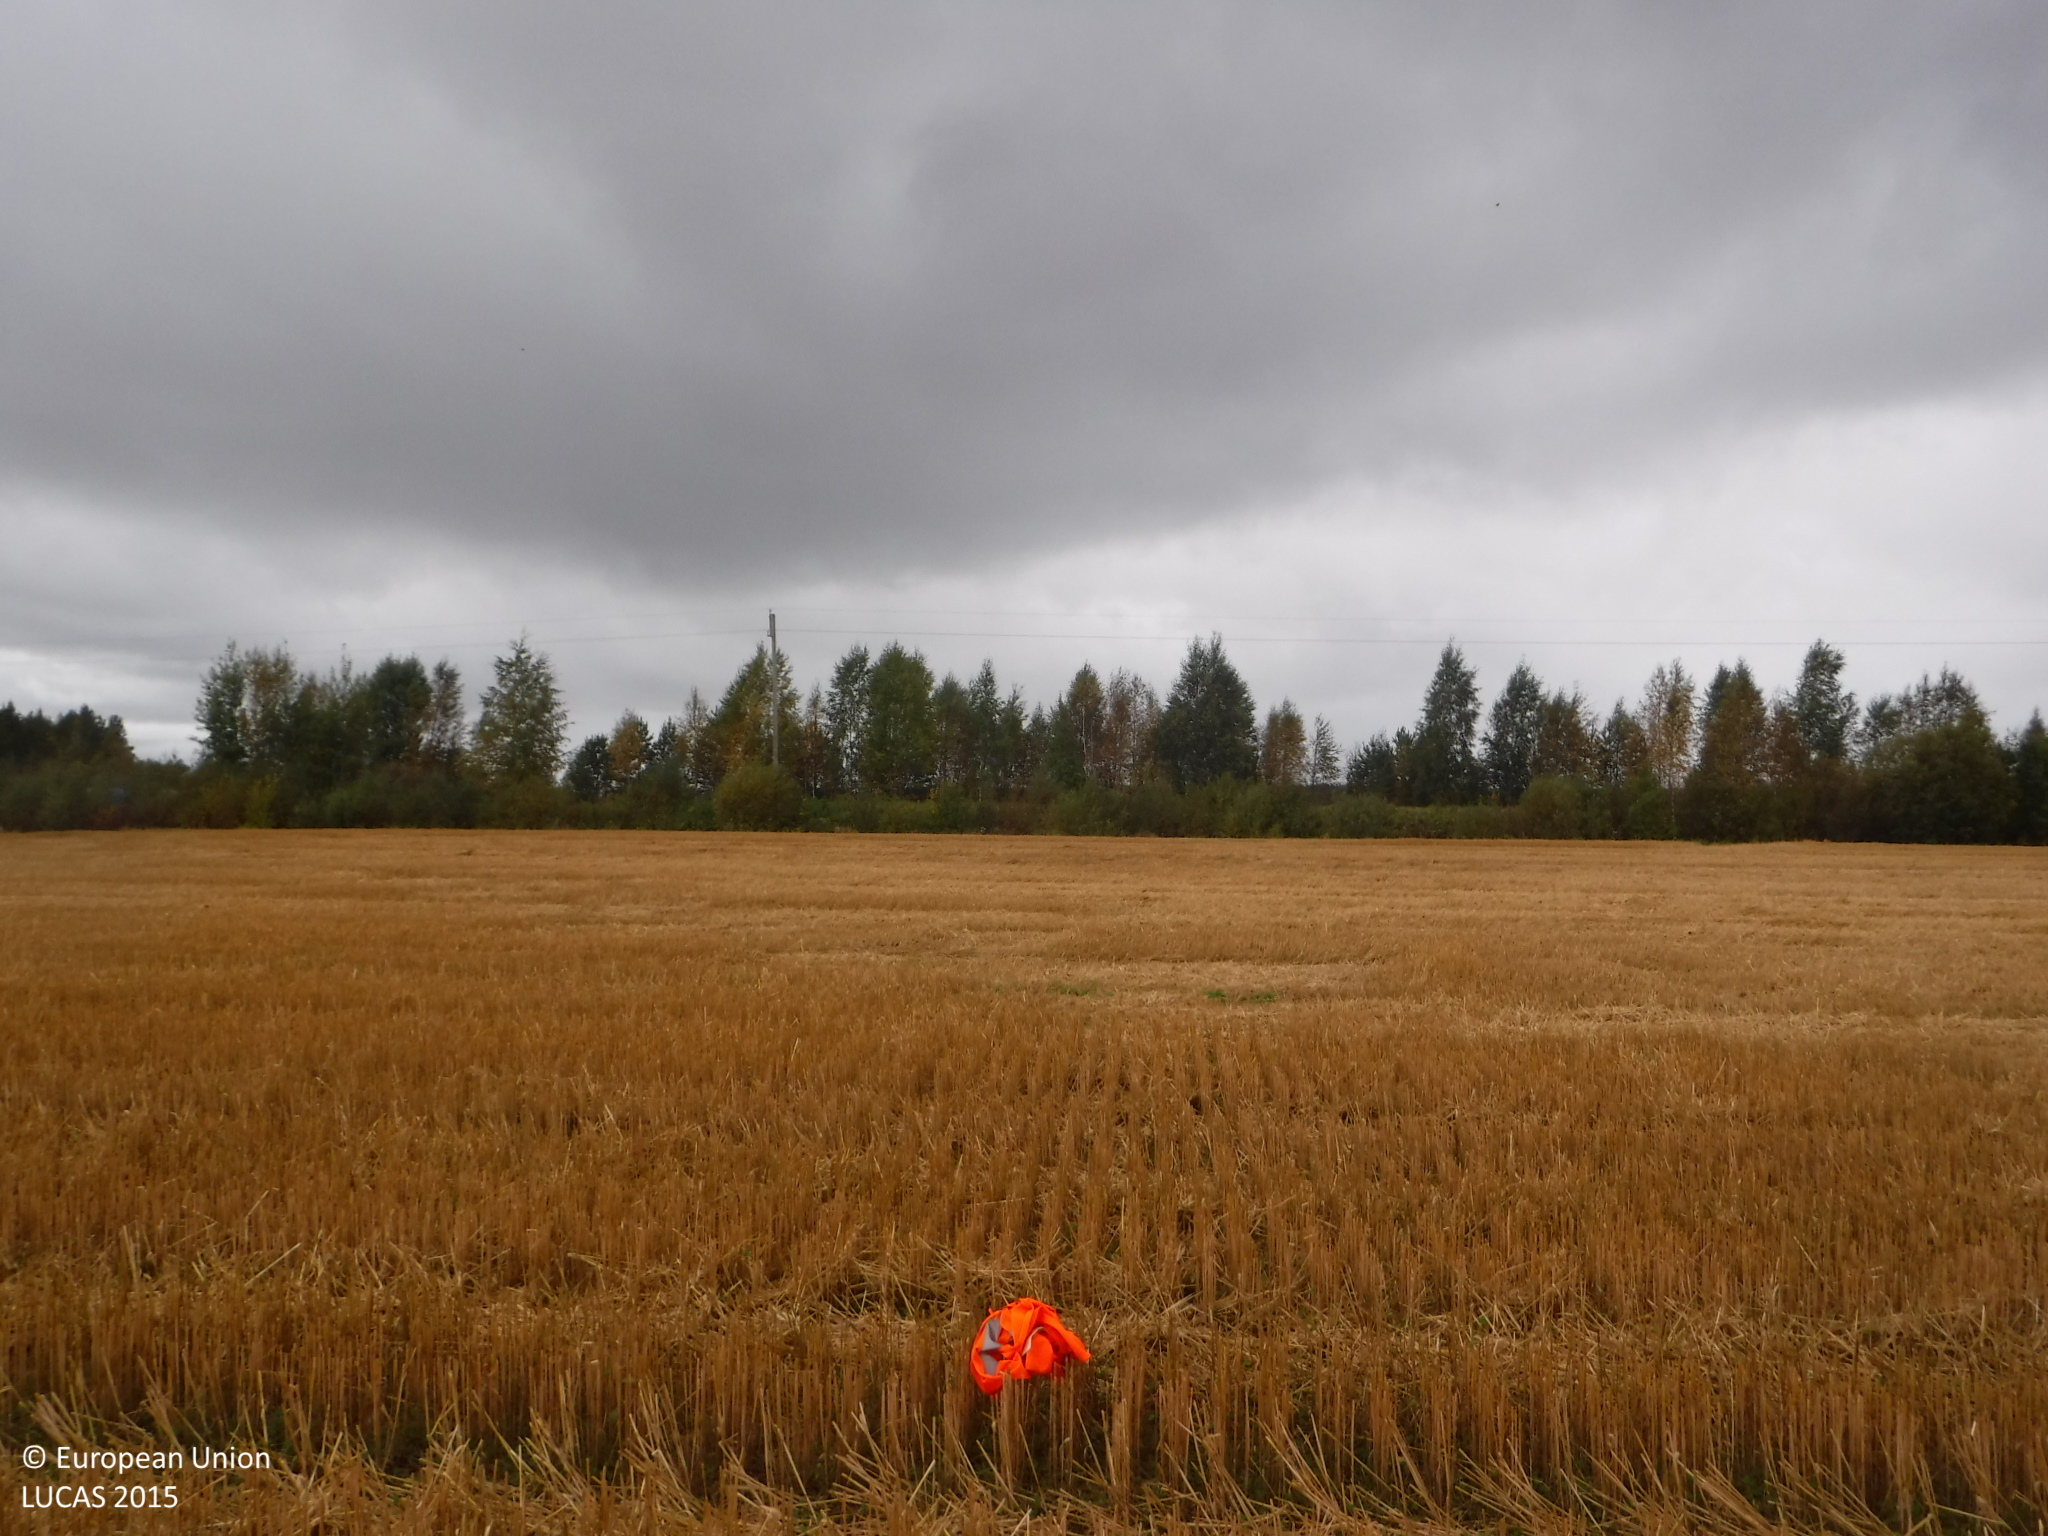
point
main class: Cropland
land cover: Oats
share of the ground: > 75 %
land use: Agriculture (excluding fallow land and kitchen gardens)
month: September
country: FI
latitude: 61.9852
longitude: 22.2127
